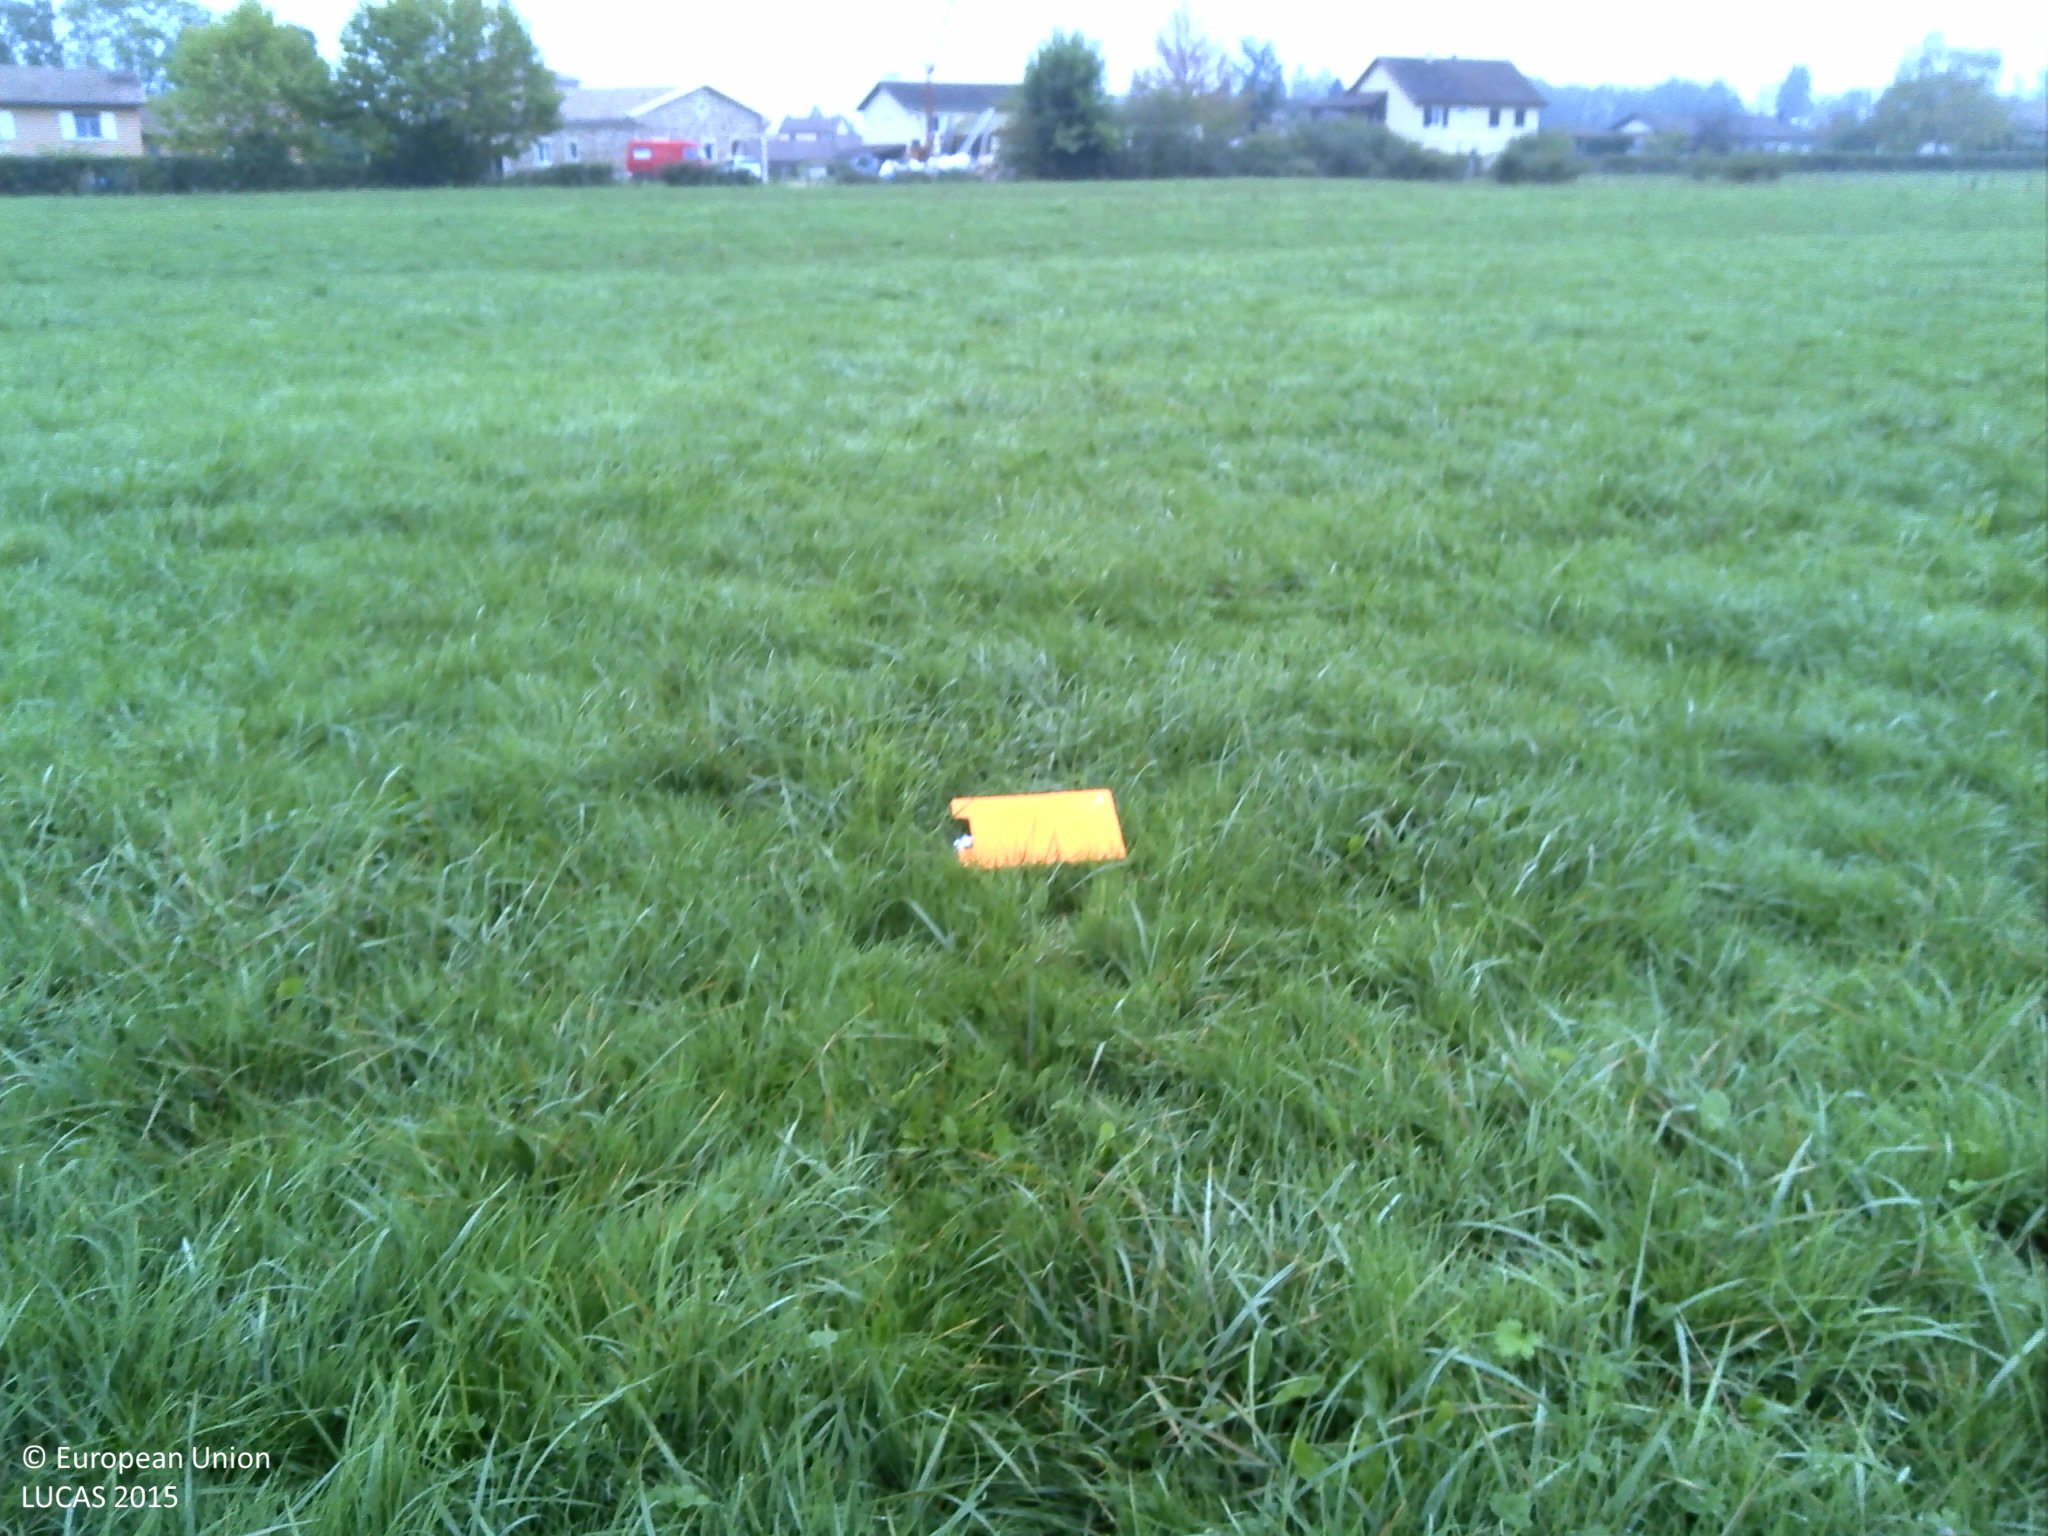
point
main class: Grassland
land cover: Grassland without tree/shrub cover
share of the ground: > 75 %
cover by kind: herbaceous plants 100 %
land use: Agriculture (excluding fallow land and kitchen gardens)
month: October
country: FR
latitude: 46.4263
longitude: 4.8621
